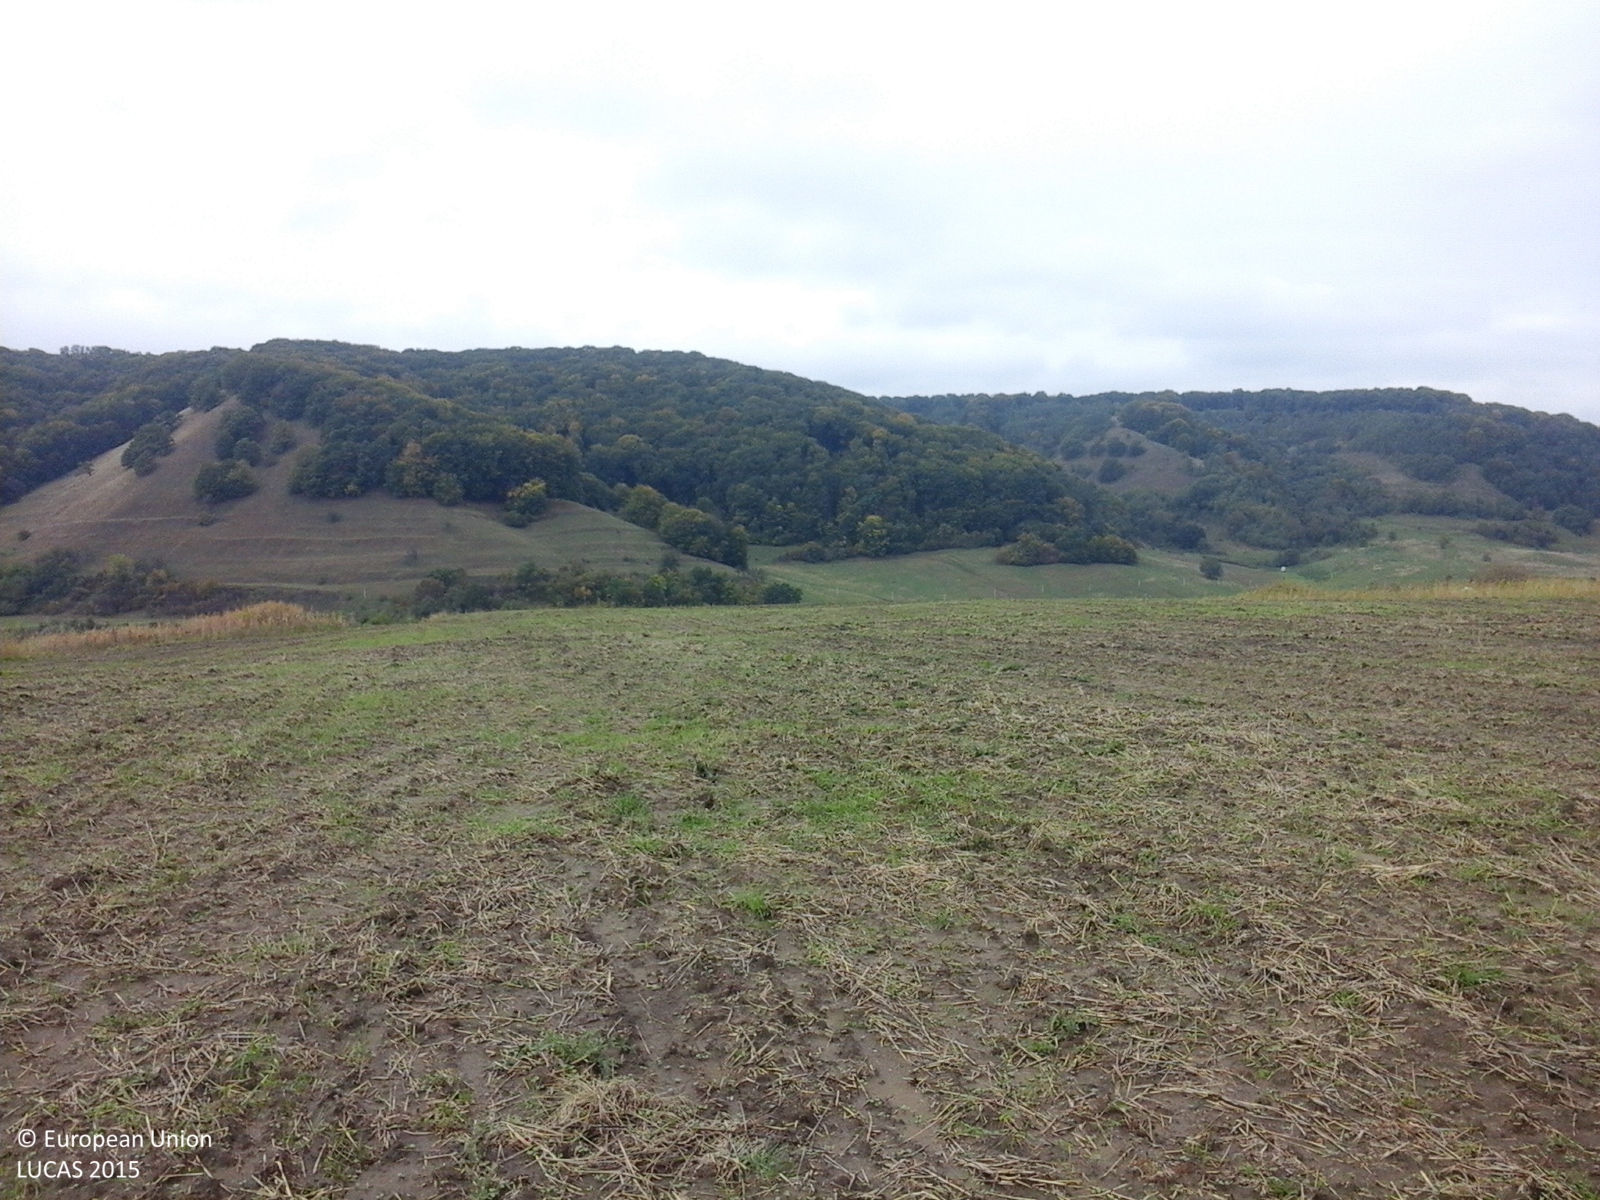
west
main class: Cropland
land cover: Rape and turnip rape
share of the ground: < 10 %
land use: Agriculture (excluding fallow land and kitchen gardens)
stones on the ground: < 10 %
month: October
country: RO
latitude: 46.1013
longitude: 24.2702
